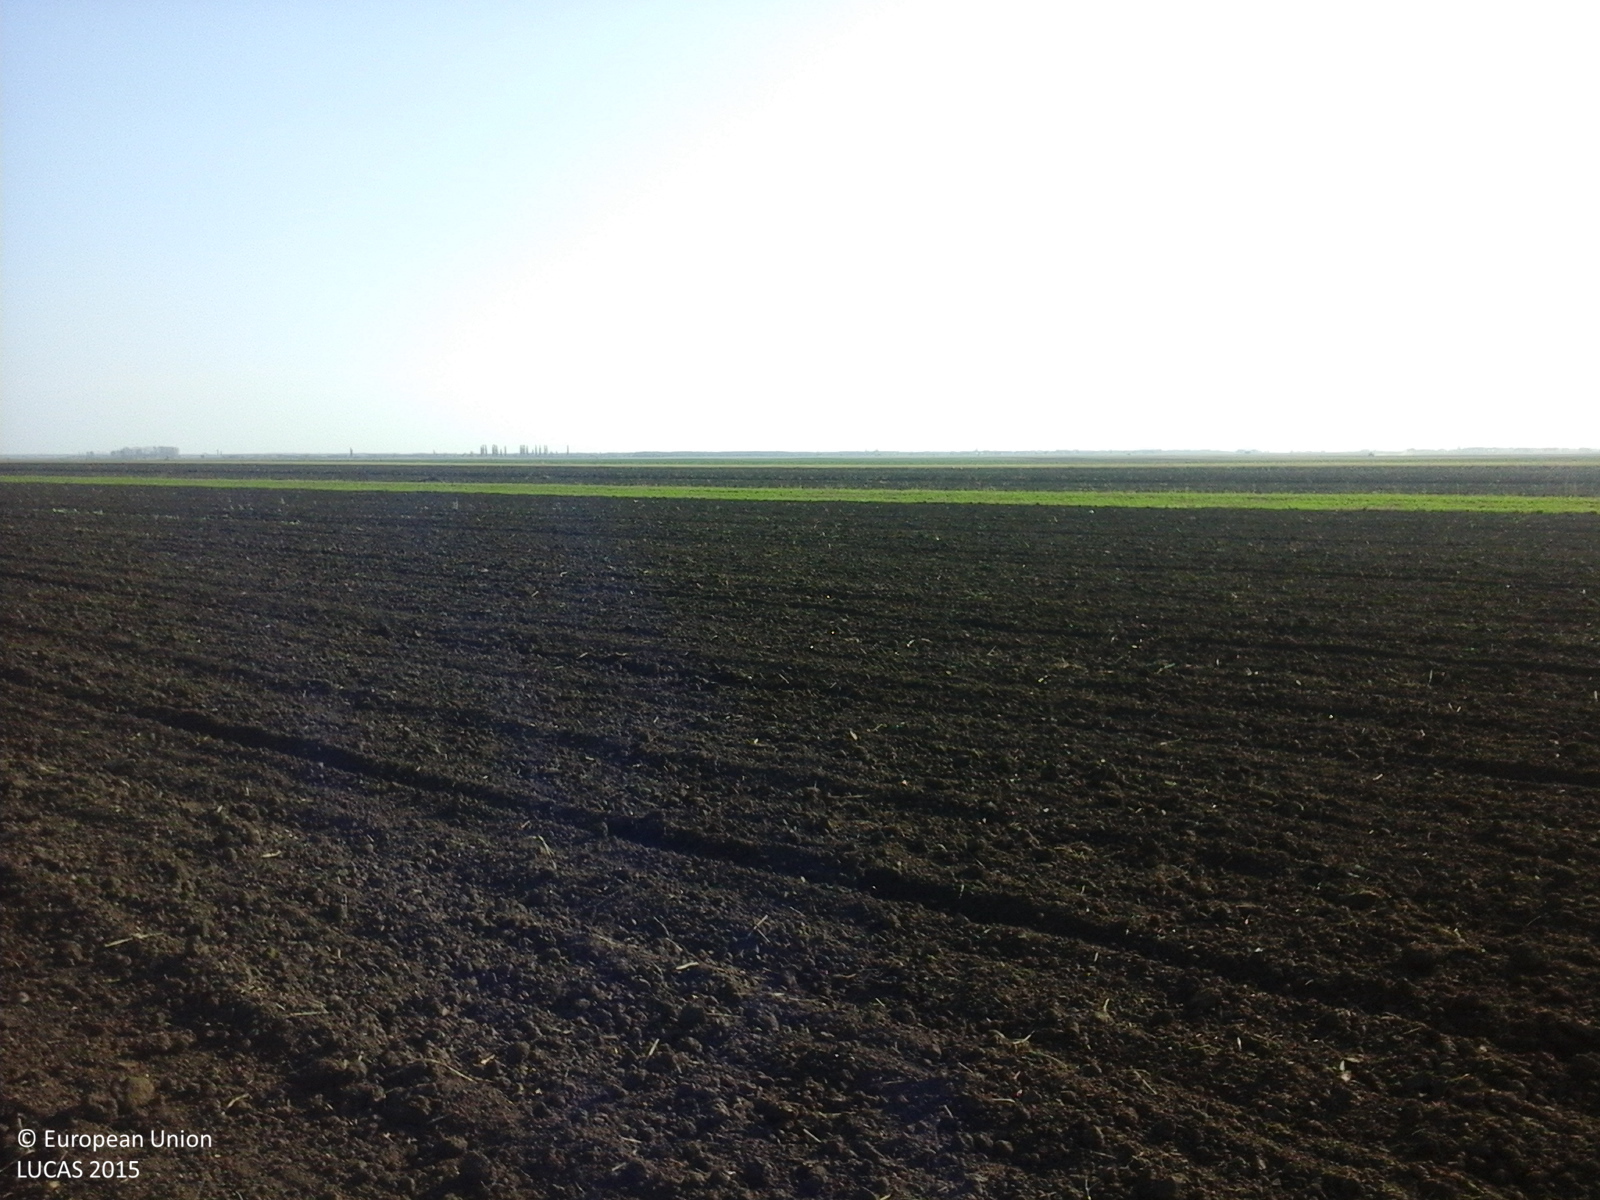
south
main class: Cropland
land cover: Common wheat
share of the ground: < 10 %
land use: Agriculture (excluding fallow land and kitchen gardens)
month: October
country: RO
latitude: 45.2005
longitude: 26.8731
